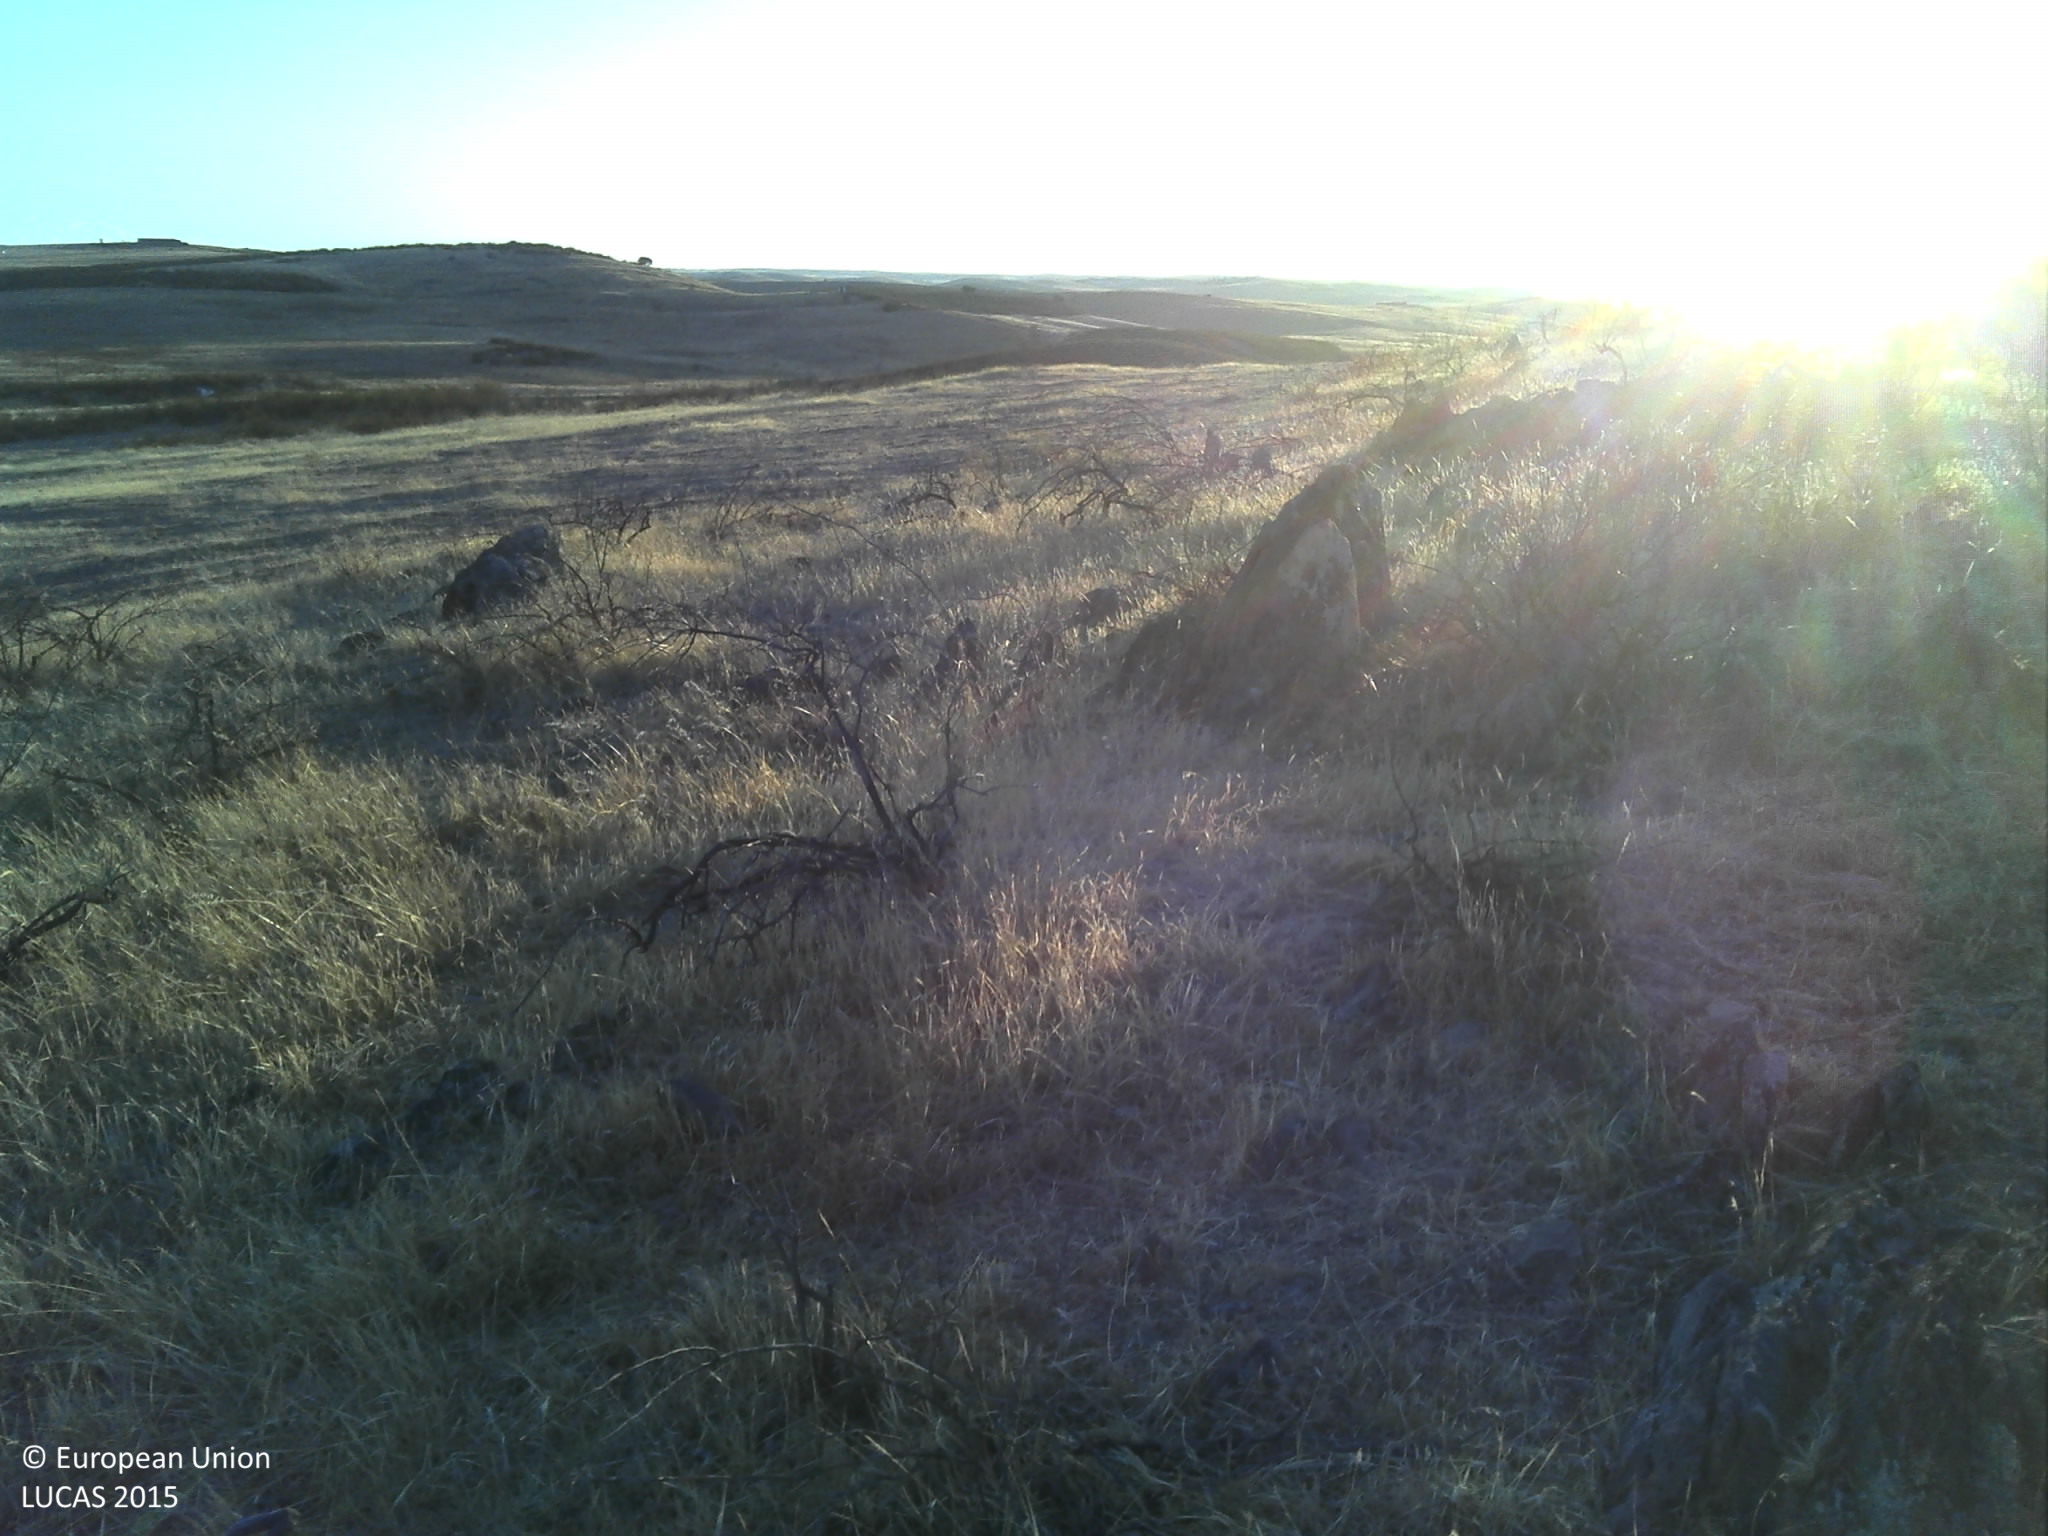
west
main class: Shrubland
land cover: Shrubland without tree cover
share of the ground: 10 - 25 %
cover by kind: unconsolidated bare surface 55 %, shrubs 20 %, herbaceous plants 20 %, consolidated bare surface 5 %
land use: Agriculture (excluding fallow land and kitchen gardens)
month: July
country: PT
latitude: 37.6279
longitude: -7.8893
